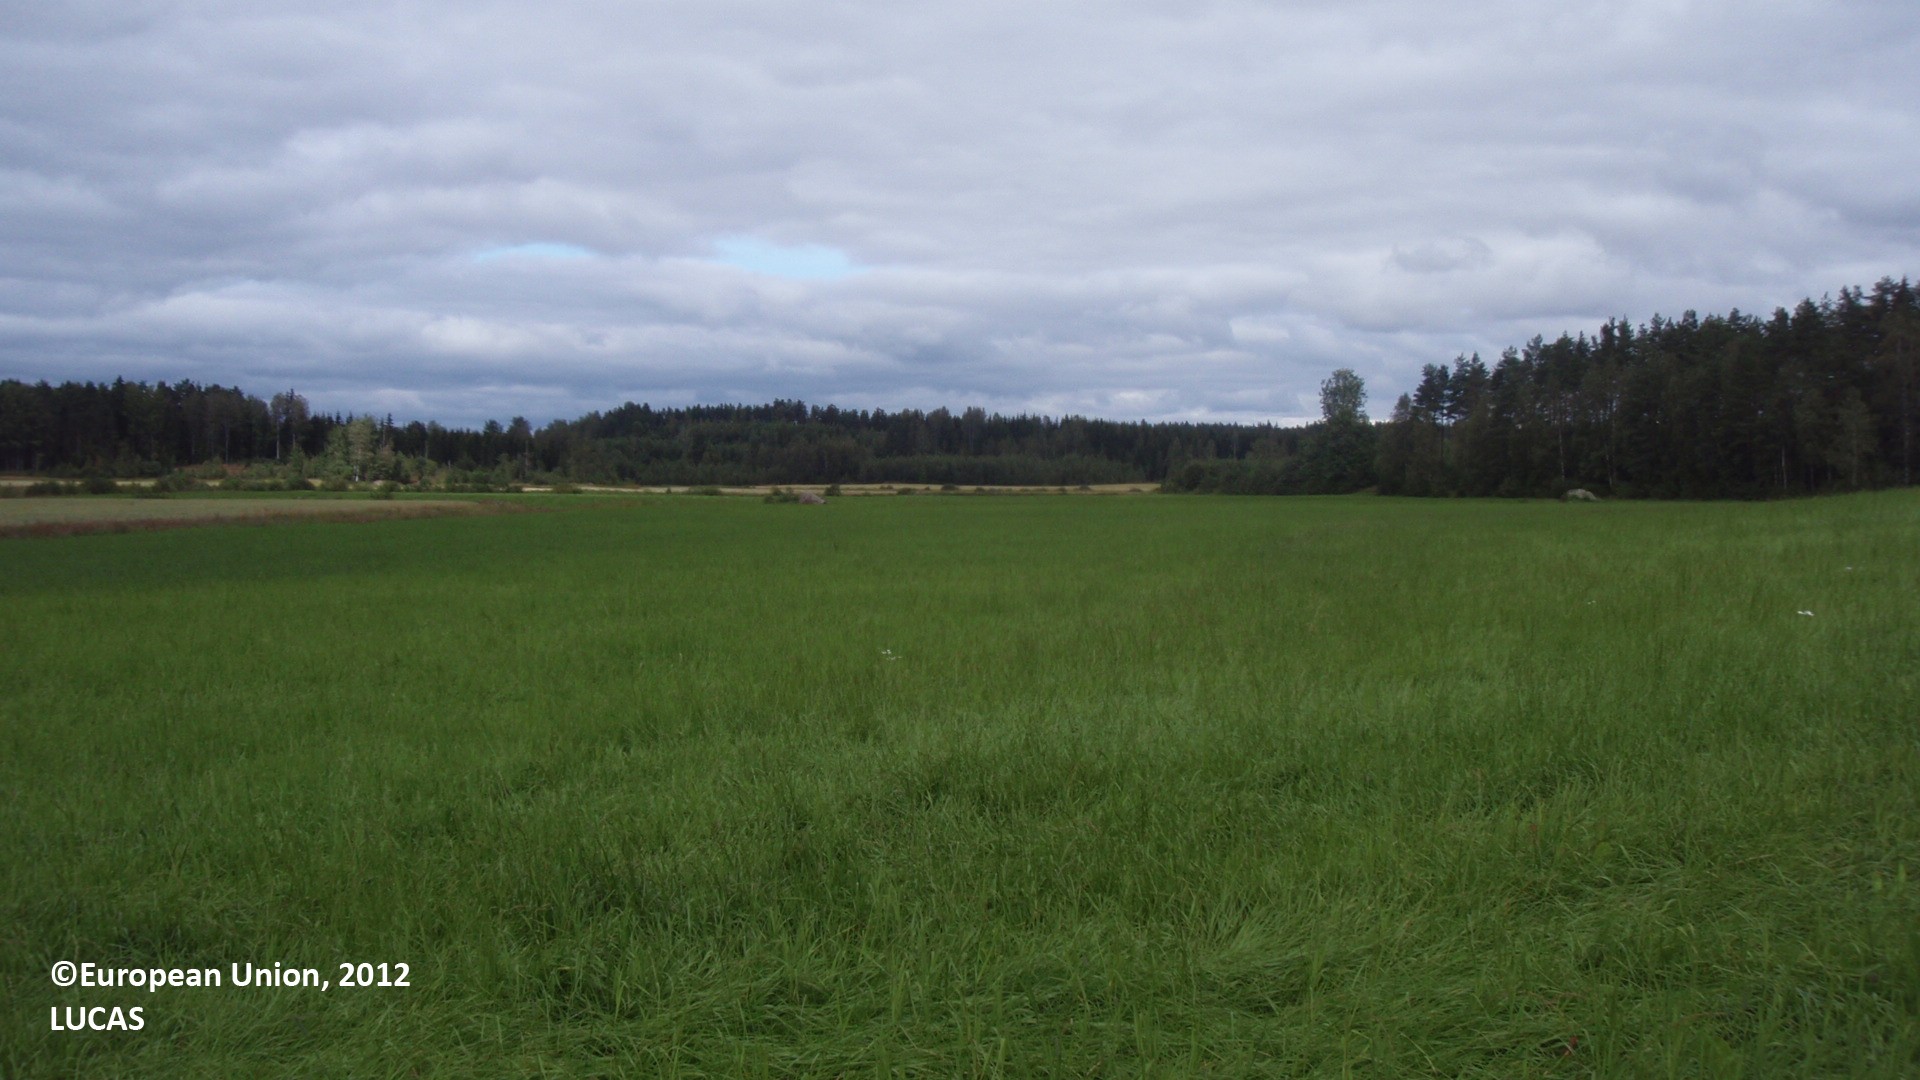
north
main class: Cropland
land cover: Mixed cereals for fodder
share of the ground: > 75 %
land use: Agriculture (excluding fallow land and kitchen gardens)
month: August
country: FI
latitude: 61.1108
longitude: 27.6467
